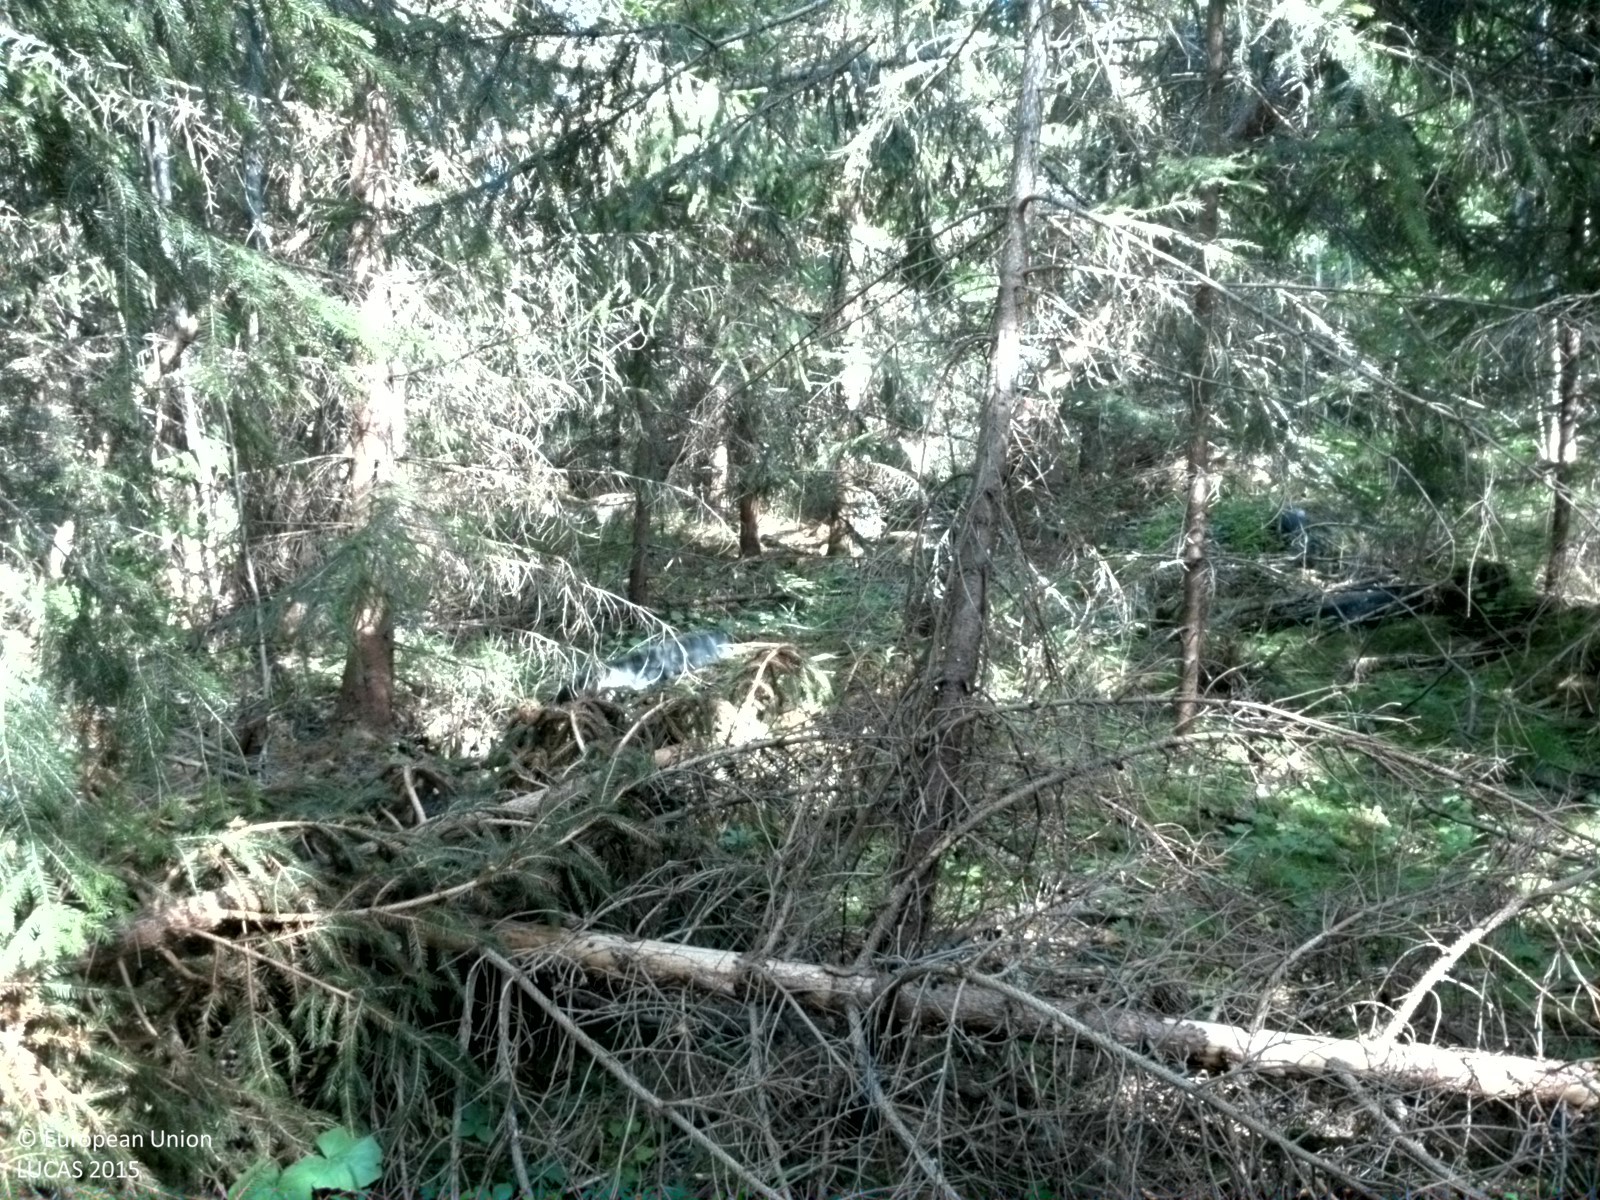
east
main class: Woodland
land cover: Spruce dominated mixed woodland
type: boreal forest
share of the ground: > 75 %
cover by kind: coniferous forest trees 55 %, broadleaved forest trees 20 %, herbaceous plants 10 %, consolidated bare surface 10 %, shrubs 5 %
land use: Forestry
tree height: > 5 m
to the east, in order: Spruce dominated mixed woodland; Spruce dominated coniferous woodland; Ditches and canals; Grass margins; Paved roads, cycling and walking lanes; Grass margins; Ditches and canals; Grassland without tree/shrub cover; Ditches and canals; Broadleaved woodland
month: June
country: SE
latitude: 60.2056
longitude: 17.6970
